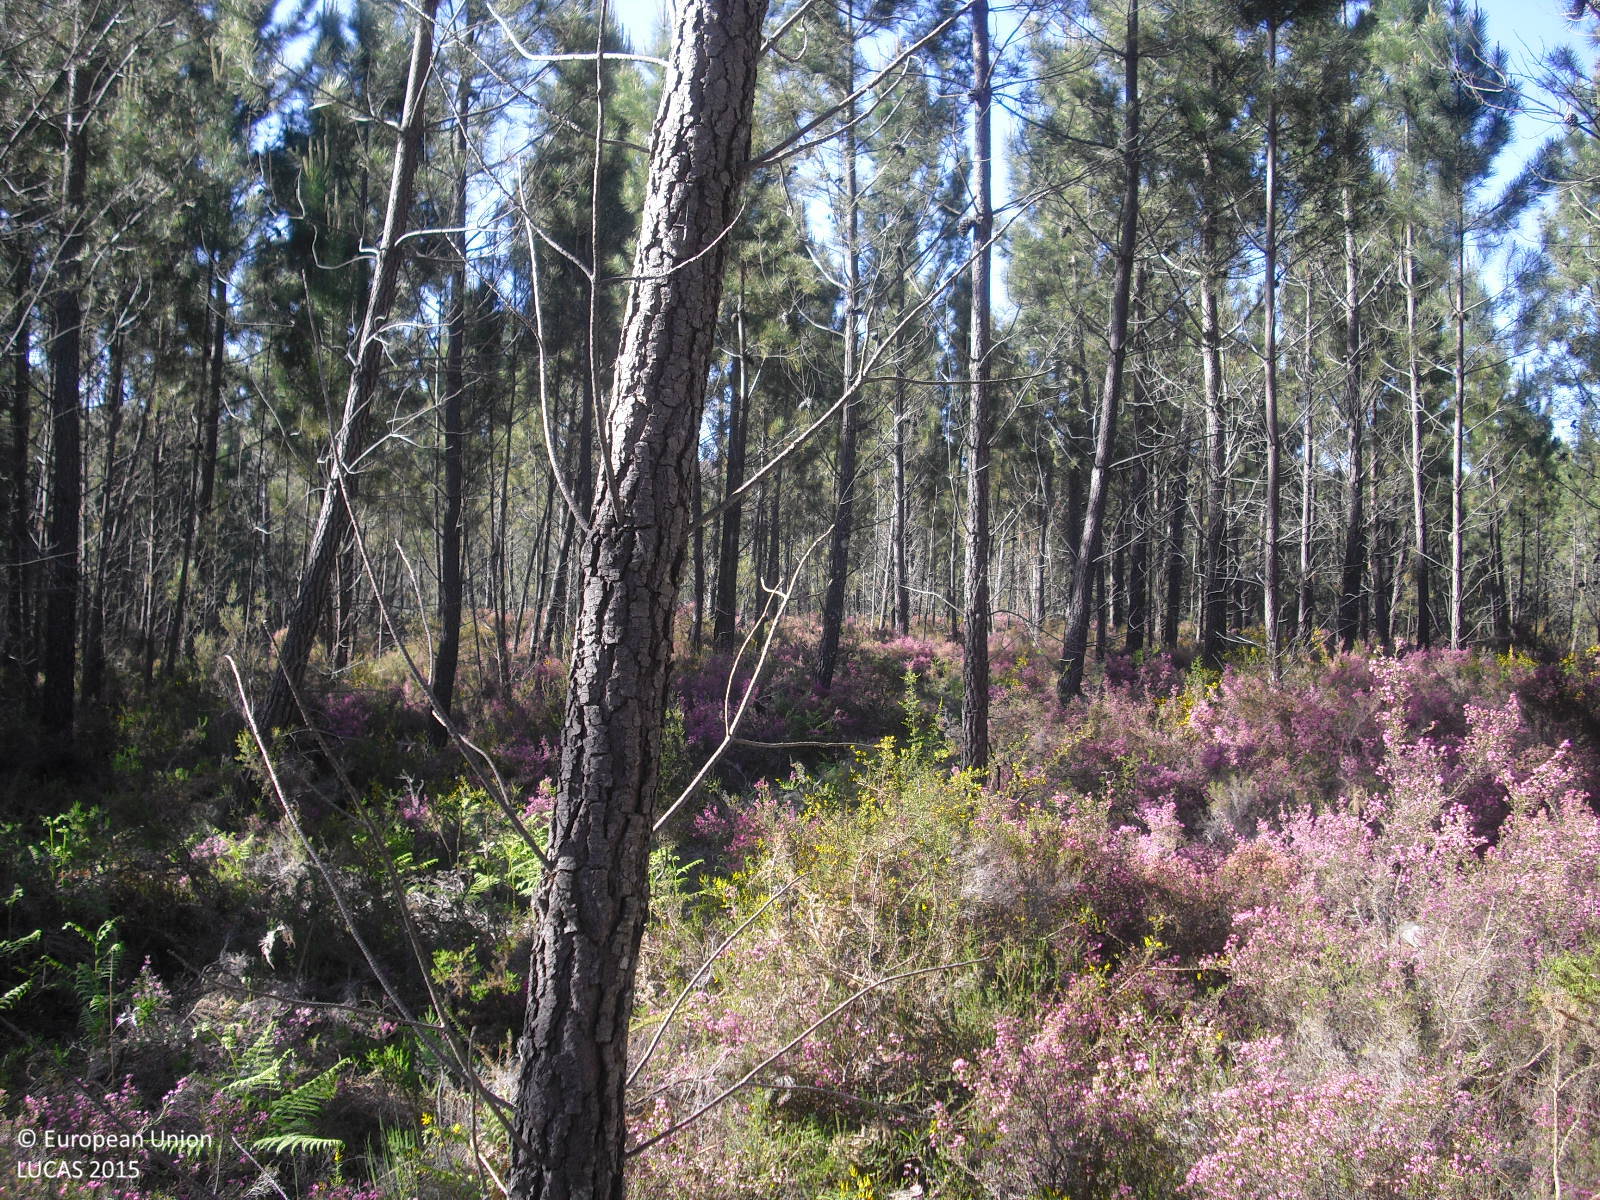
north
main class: Woodland
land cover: Pine dominated coniferous woodland
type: exotic forest
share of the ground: 25 - 50 %
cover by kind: shrubs 60 %, coniferous forest trees 40 %
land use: Forestry
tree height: > 5 m
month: May
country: ES
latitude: 41.9204
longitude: -8.1541
